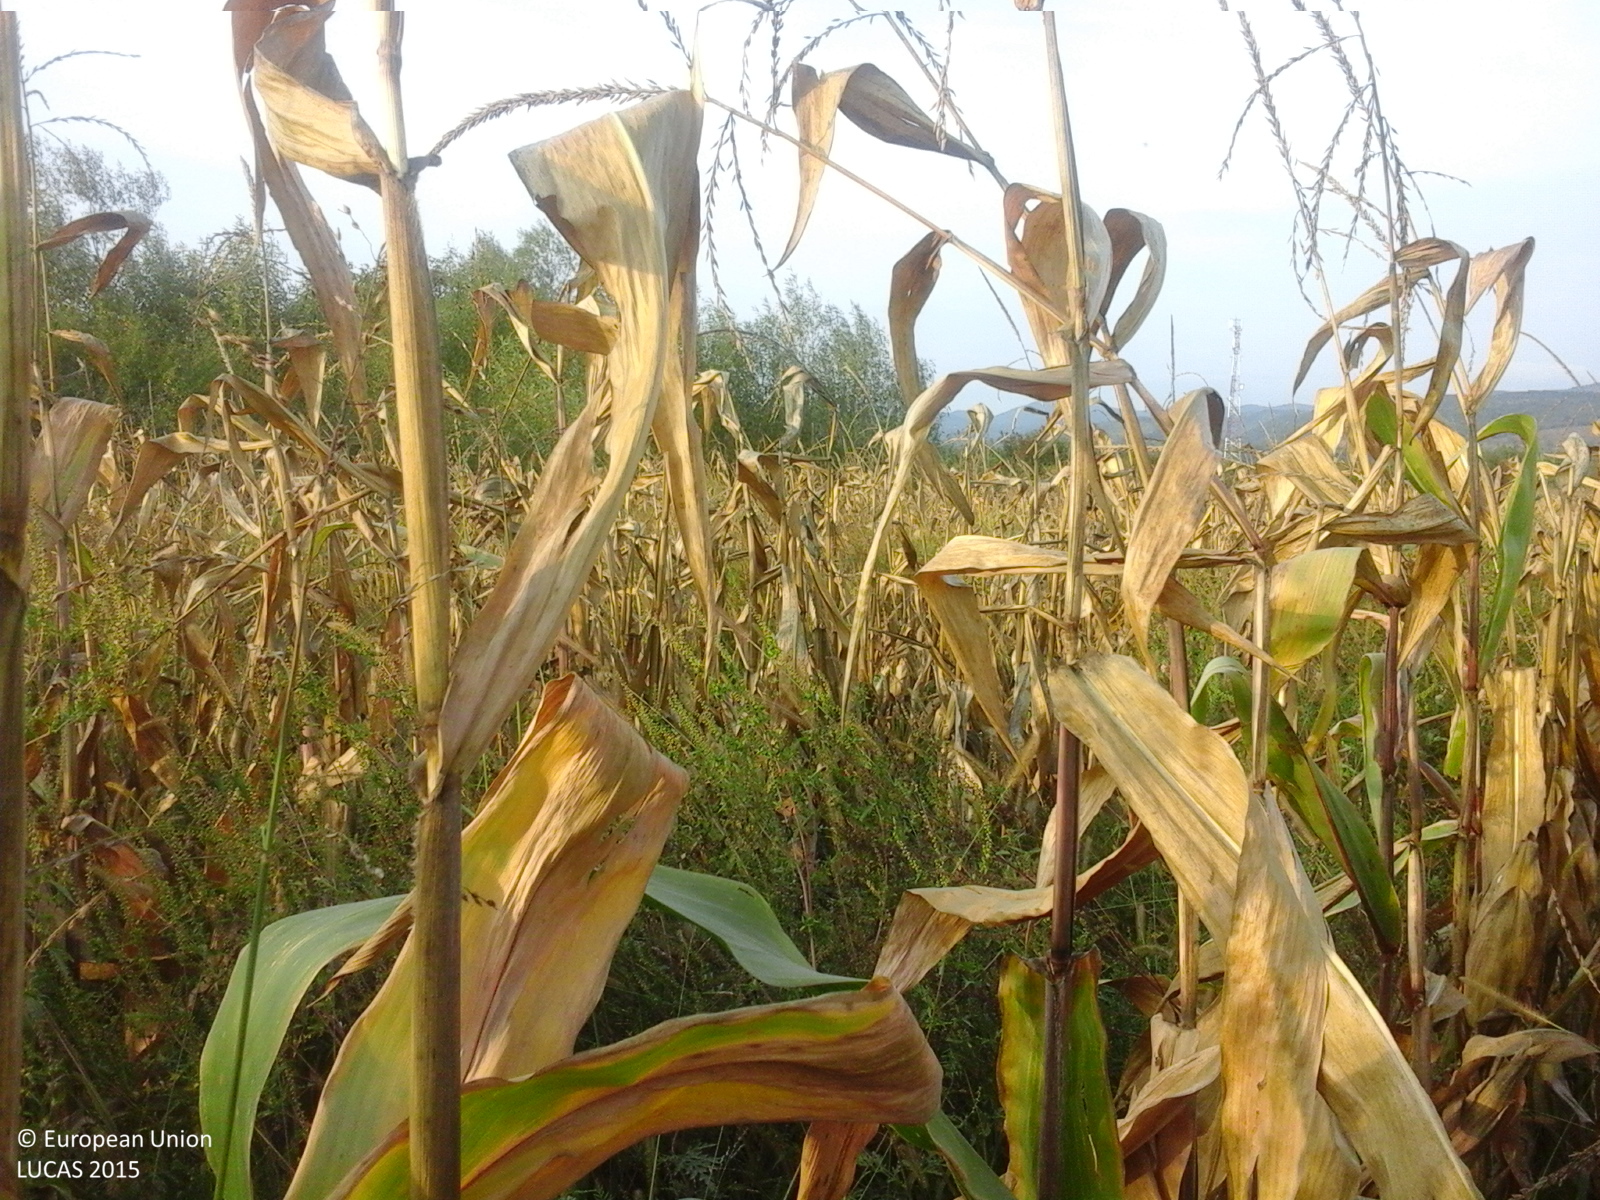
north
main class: Cropland
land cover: Maize
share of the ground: > 75 %
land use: Agriculture (excluding fallow land and kitchen gardens)
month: September
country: RO
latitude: 45.5471
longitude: 22.1446
